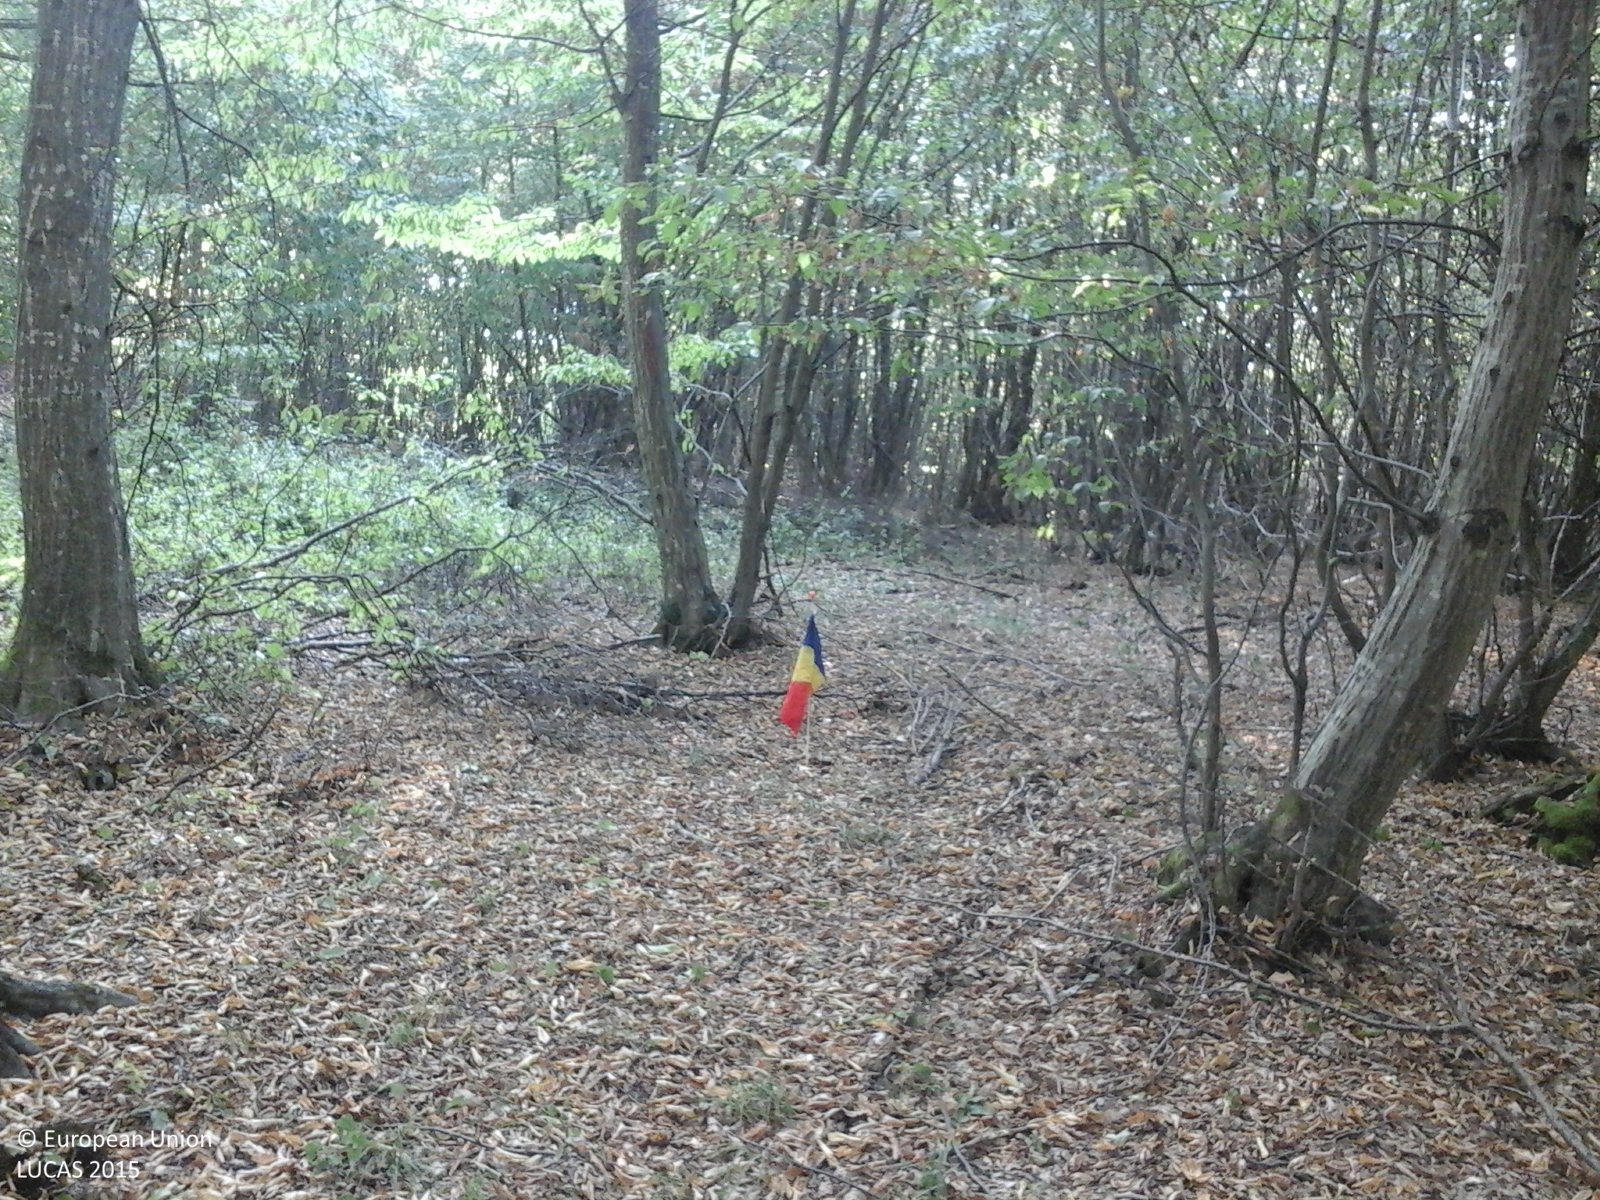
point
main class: Woodland
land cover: Broadleaved woodland
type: beech forest
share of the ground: > 75 %
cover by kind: broadleaved forest trees 100 %
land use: Forestry
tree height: > 5 m
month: September
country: RO
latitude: 46.8803
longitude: 24.4570
